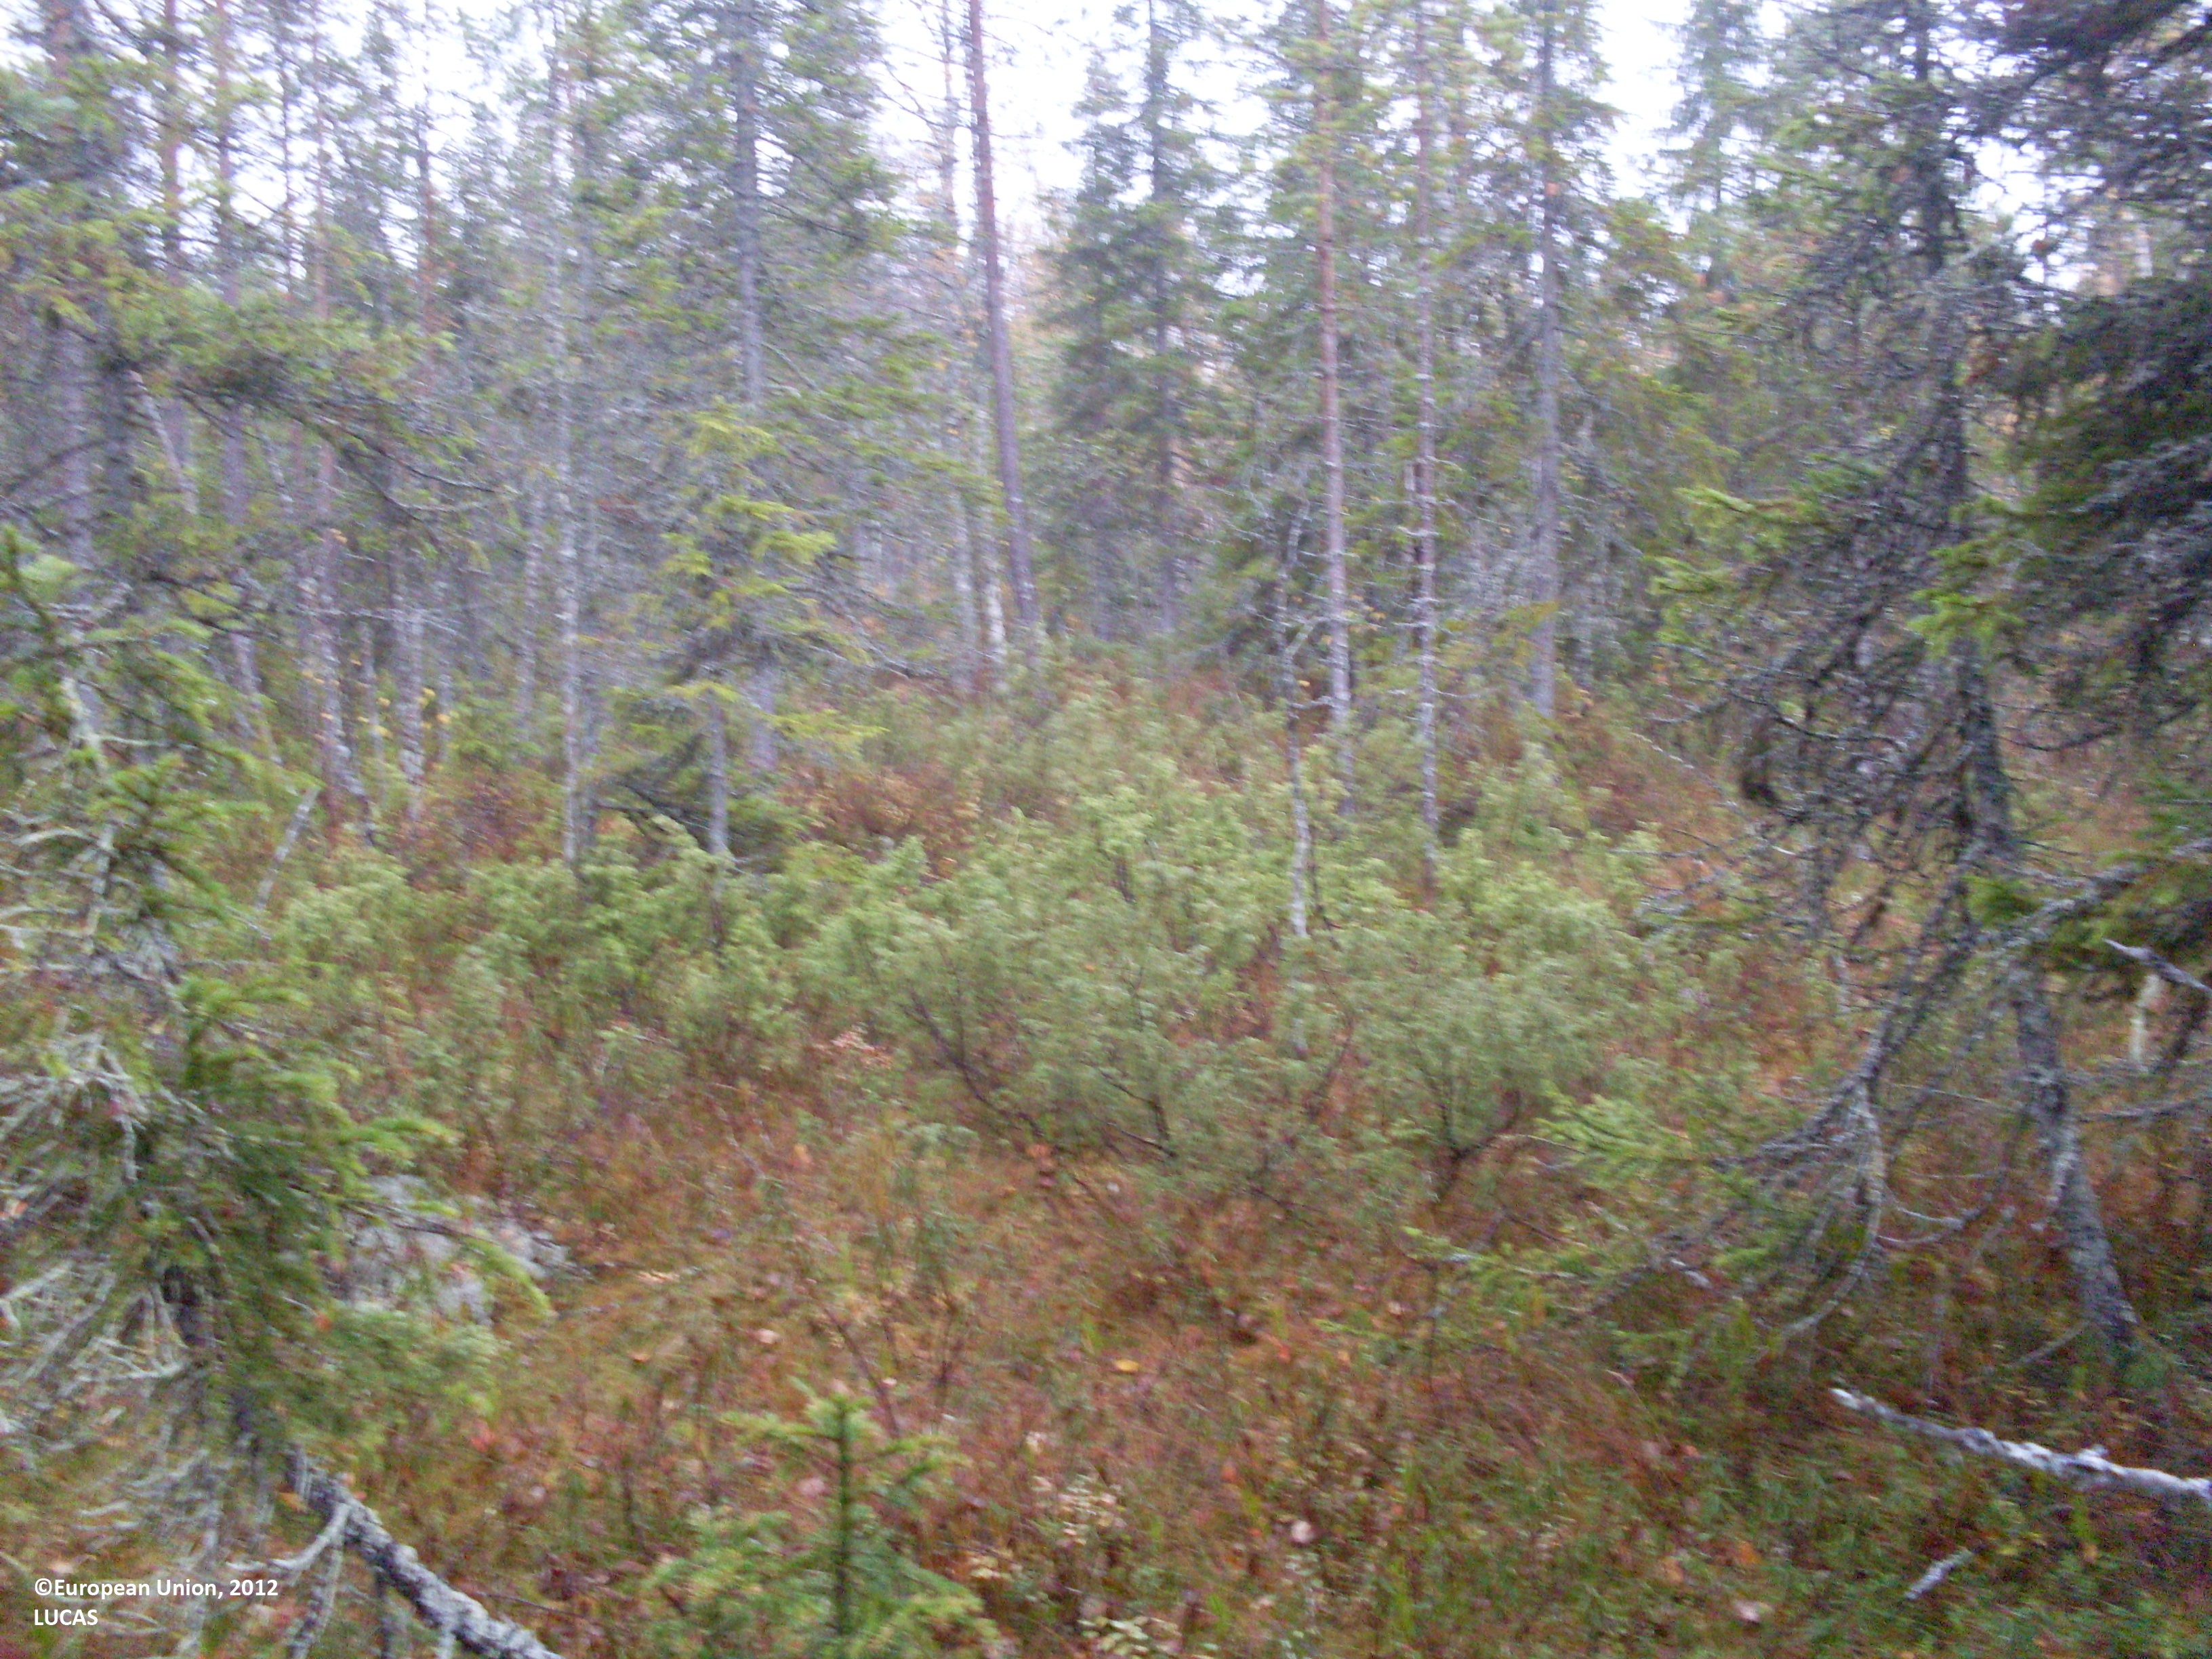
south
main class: Woodland
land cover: Pine dominated coniferous woodland
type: boreal forest
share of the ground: 50 - 75 %
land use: Forestry
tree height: > 5 m
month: September
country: FI
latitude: 64.3990
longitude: 29.0951
